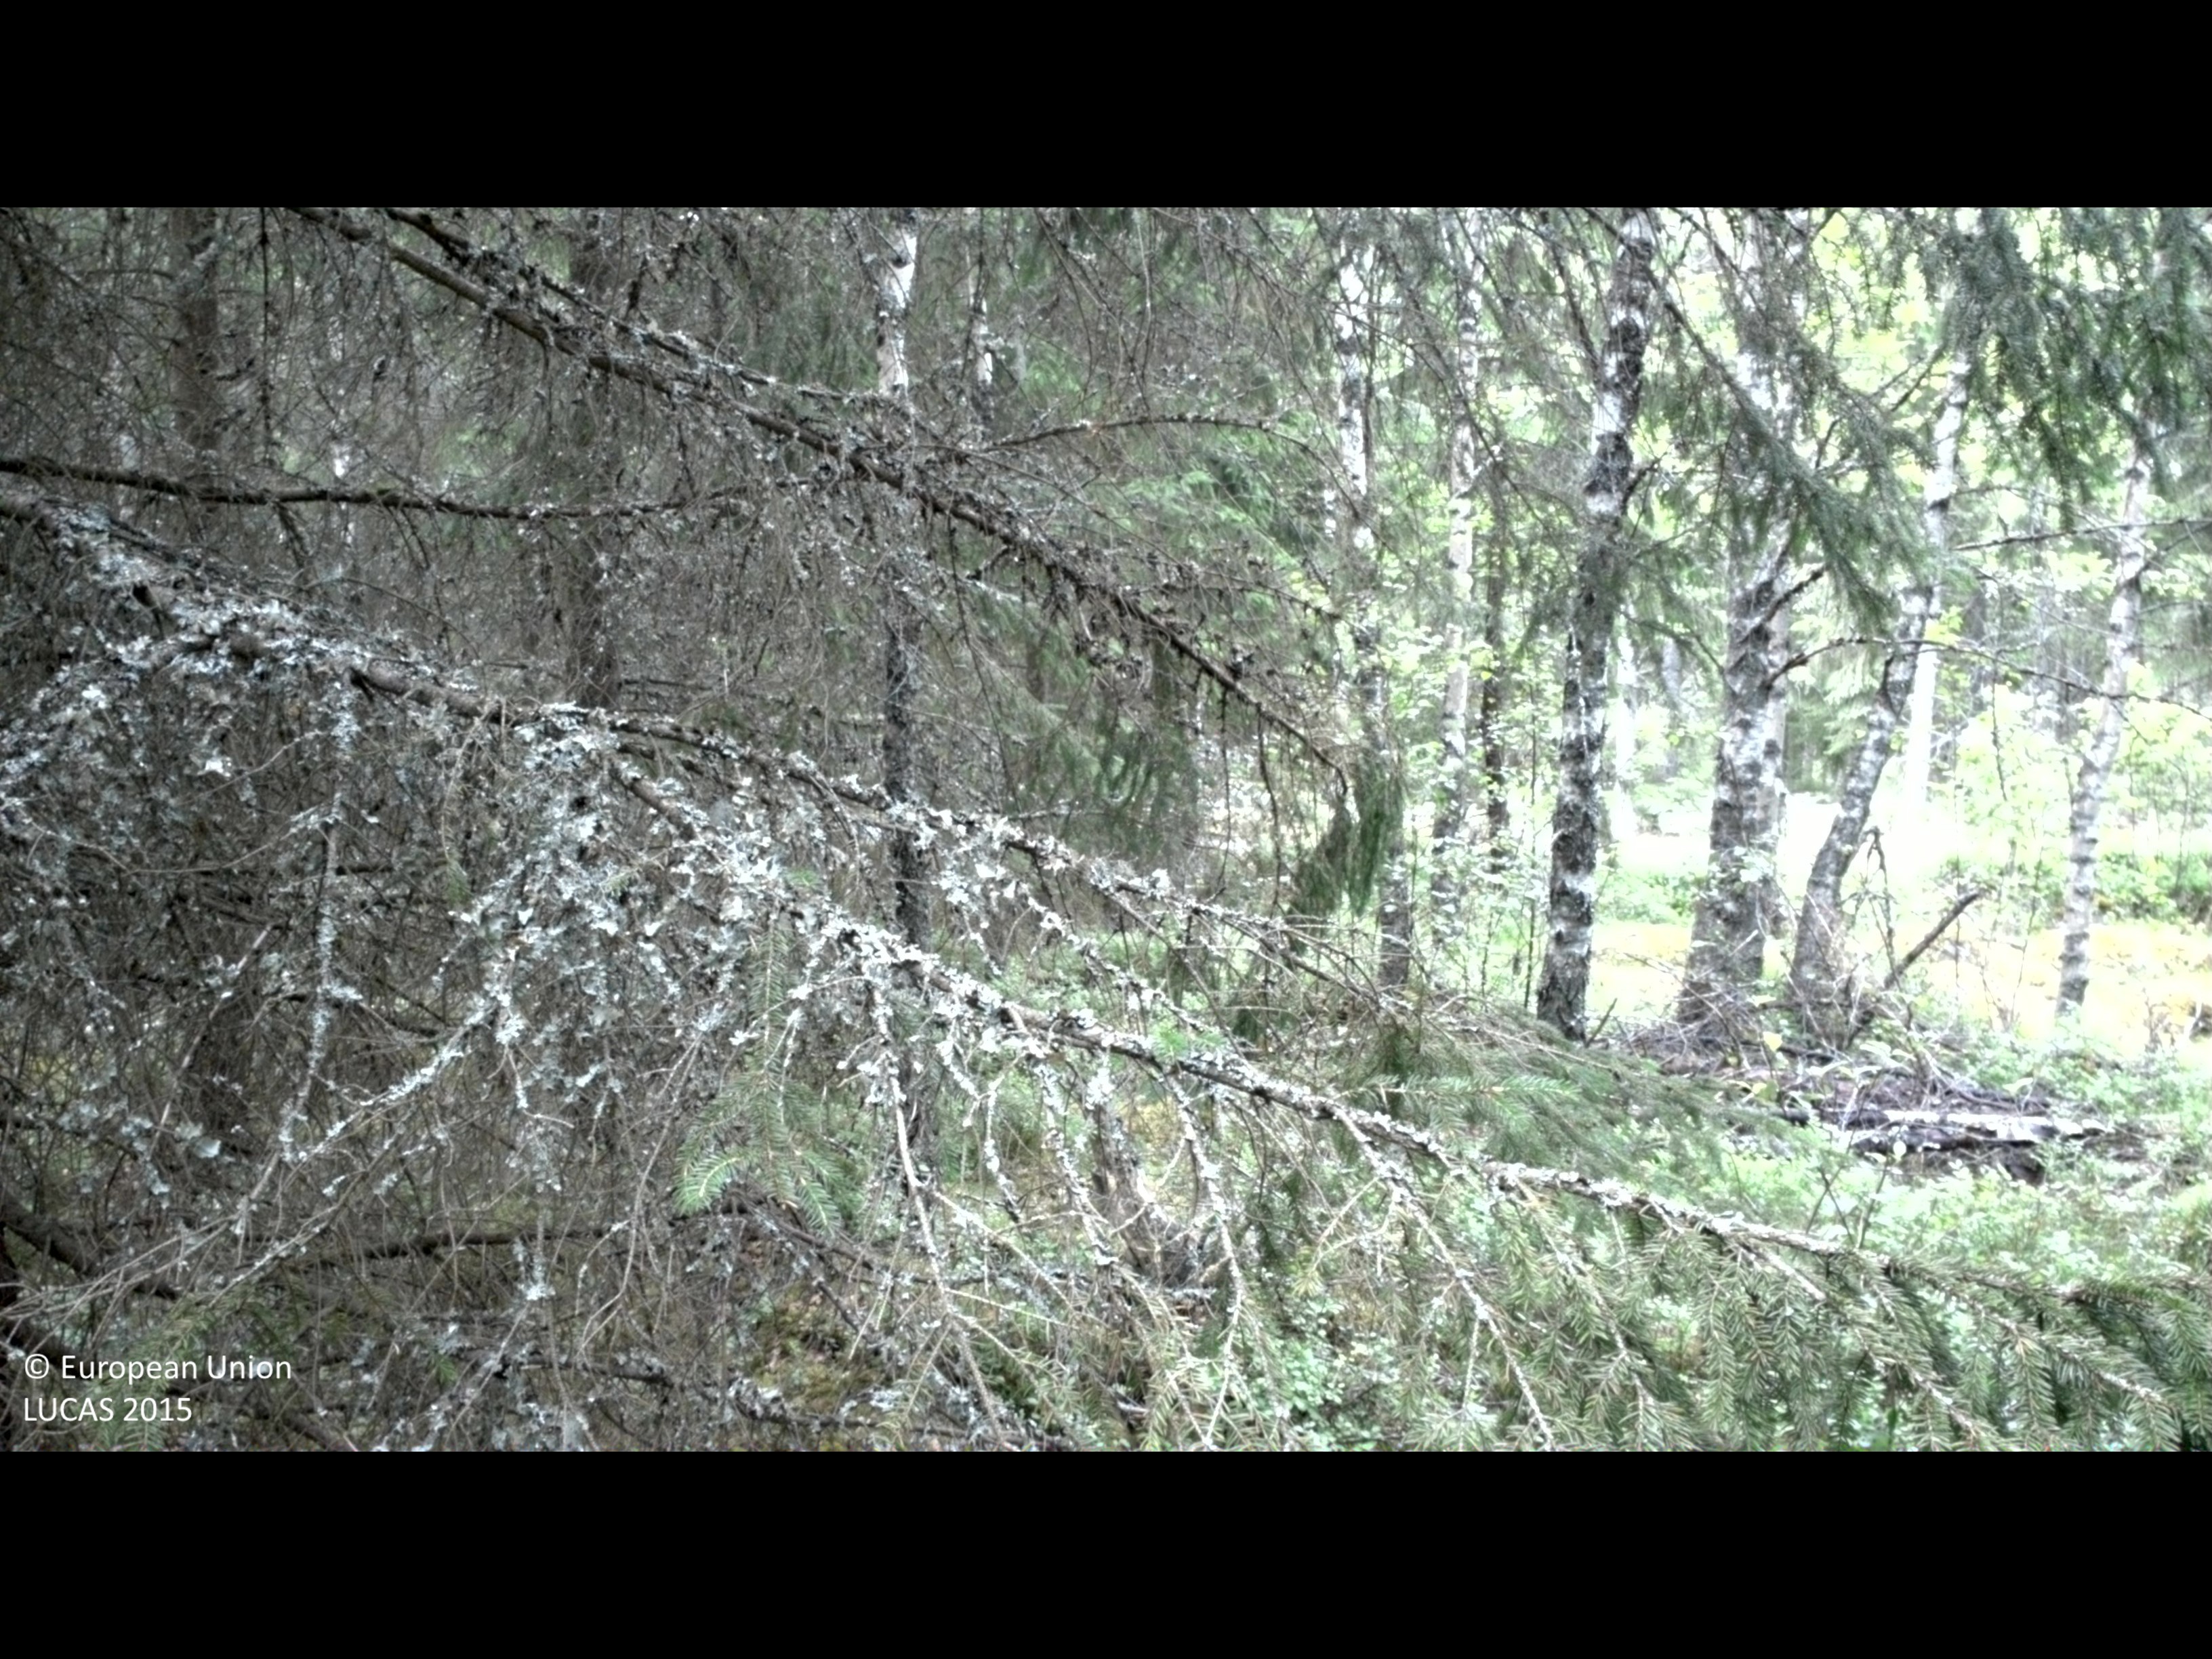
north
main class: Woodland
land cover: Spruce dominated mixed woodland
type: boreal forest
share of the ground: 50 - 75 %
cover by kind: coniferous forest trees 50 %, shrubs 25 %, broadleaved forest trees 20 %, lichens and mosses 5 %
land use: Forestry
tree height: > 5 m
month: July
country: SE
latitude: 56.5063
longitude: 14.4657
